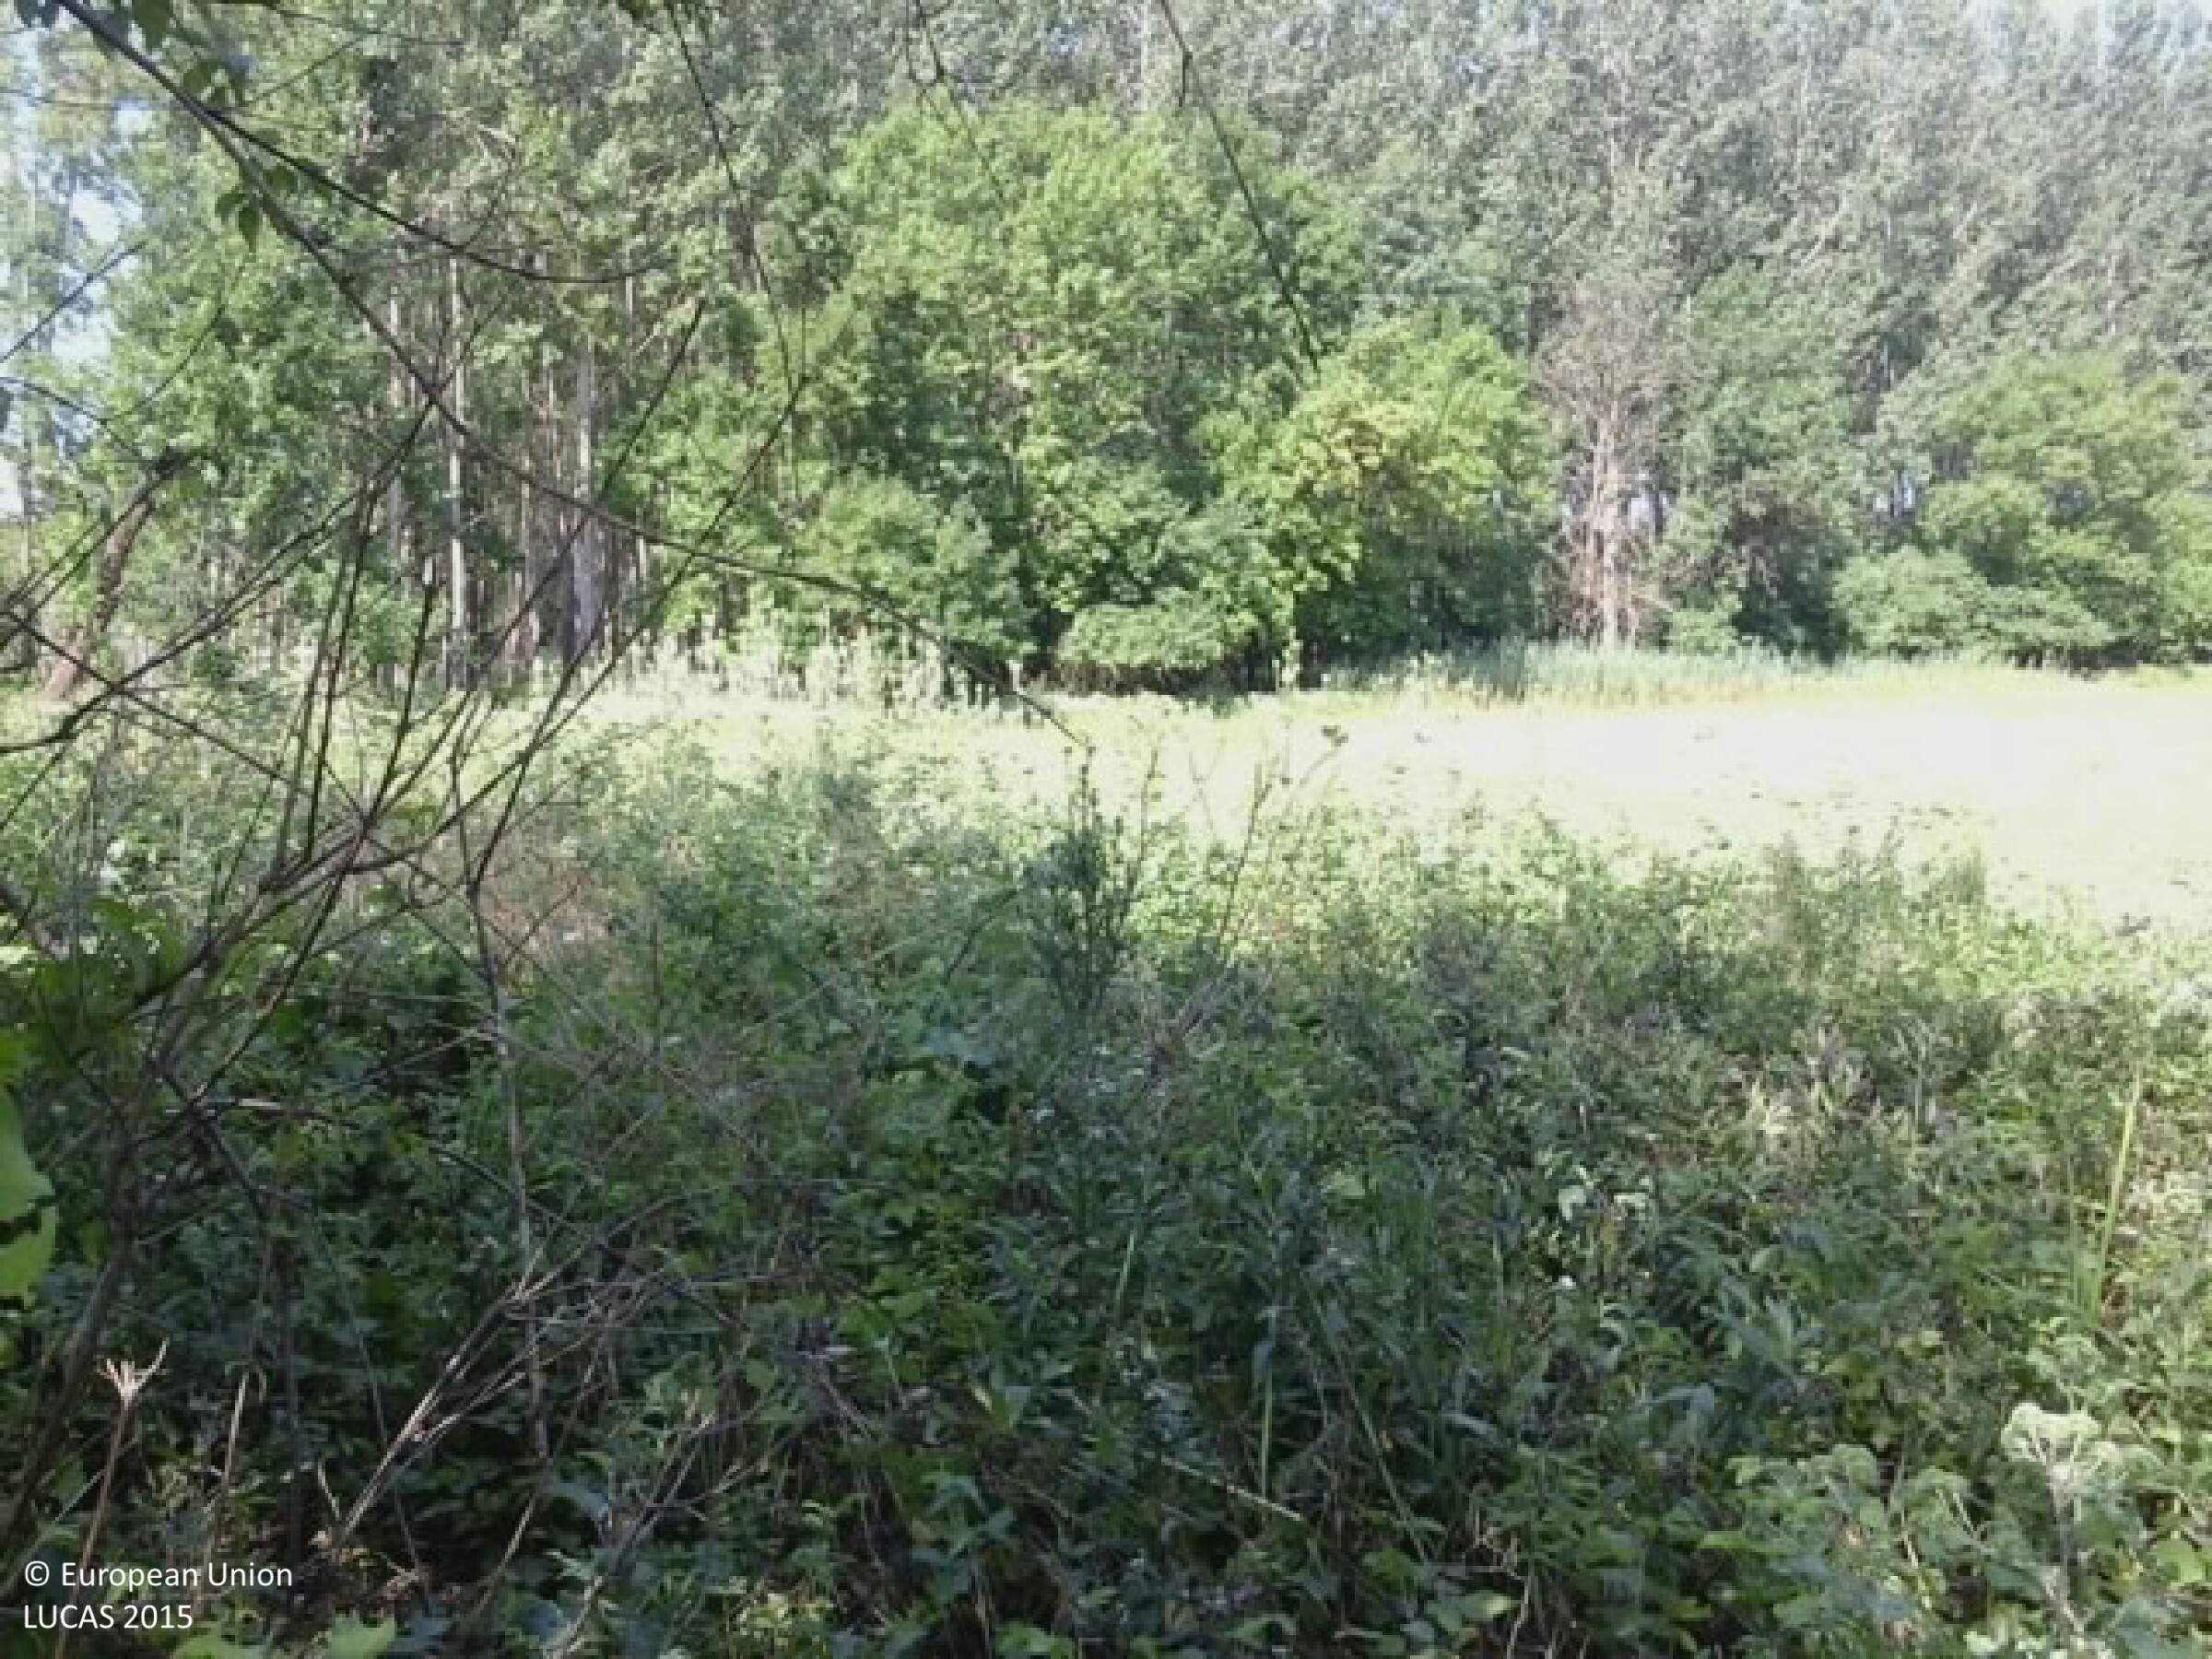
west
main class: Woodland
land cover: Broadleaved woodland
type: mesophytic deciduous forest
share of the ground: 25 - 50 %
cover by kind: broadleaved forest trees 60 %, herbaceous plants 25 %, shrubs 15 %
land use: Forestry
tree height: < 5 m
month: July
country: HU
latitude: 46.3252
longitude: 18.8834
